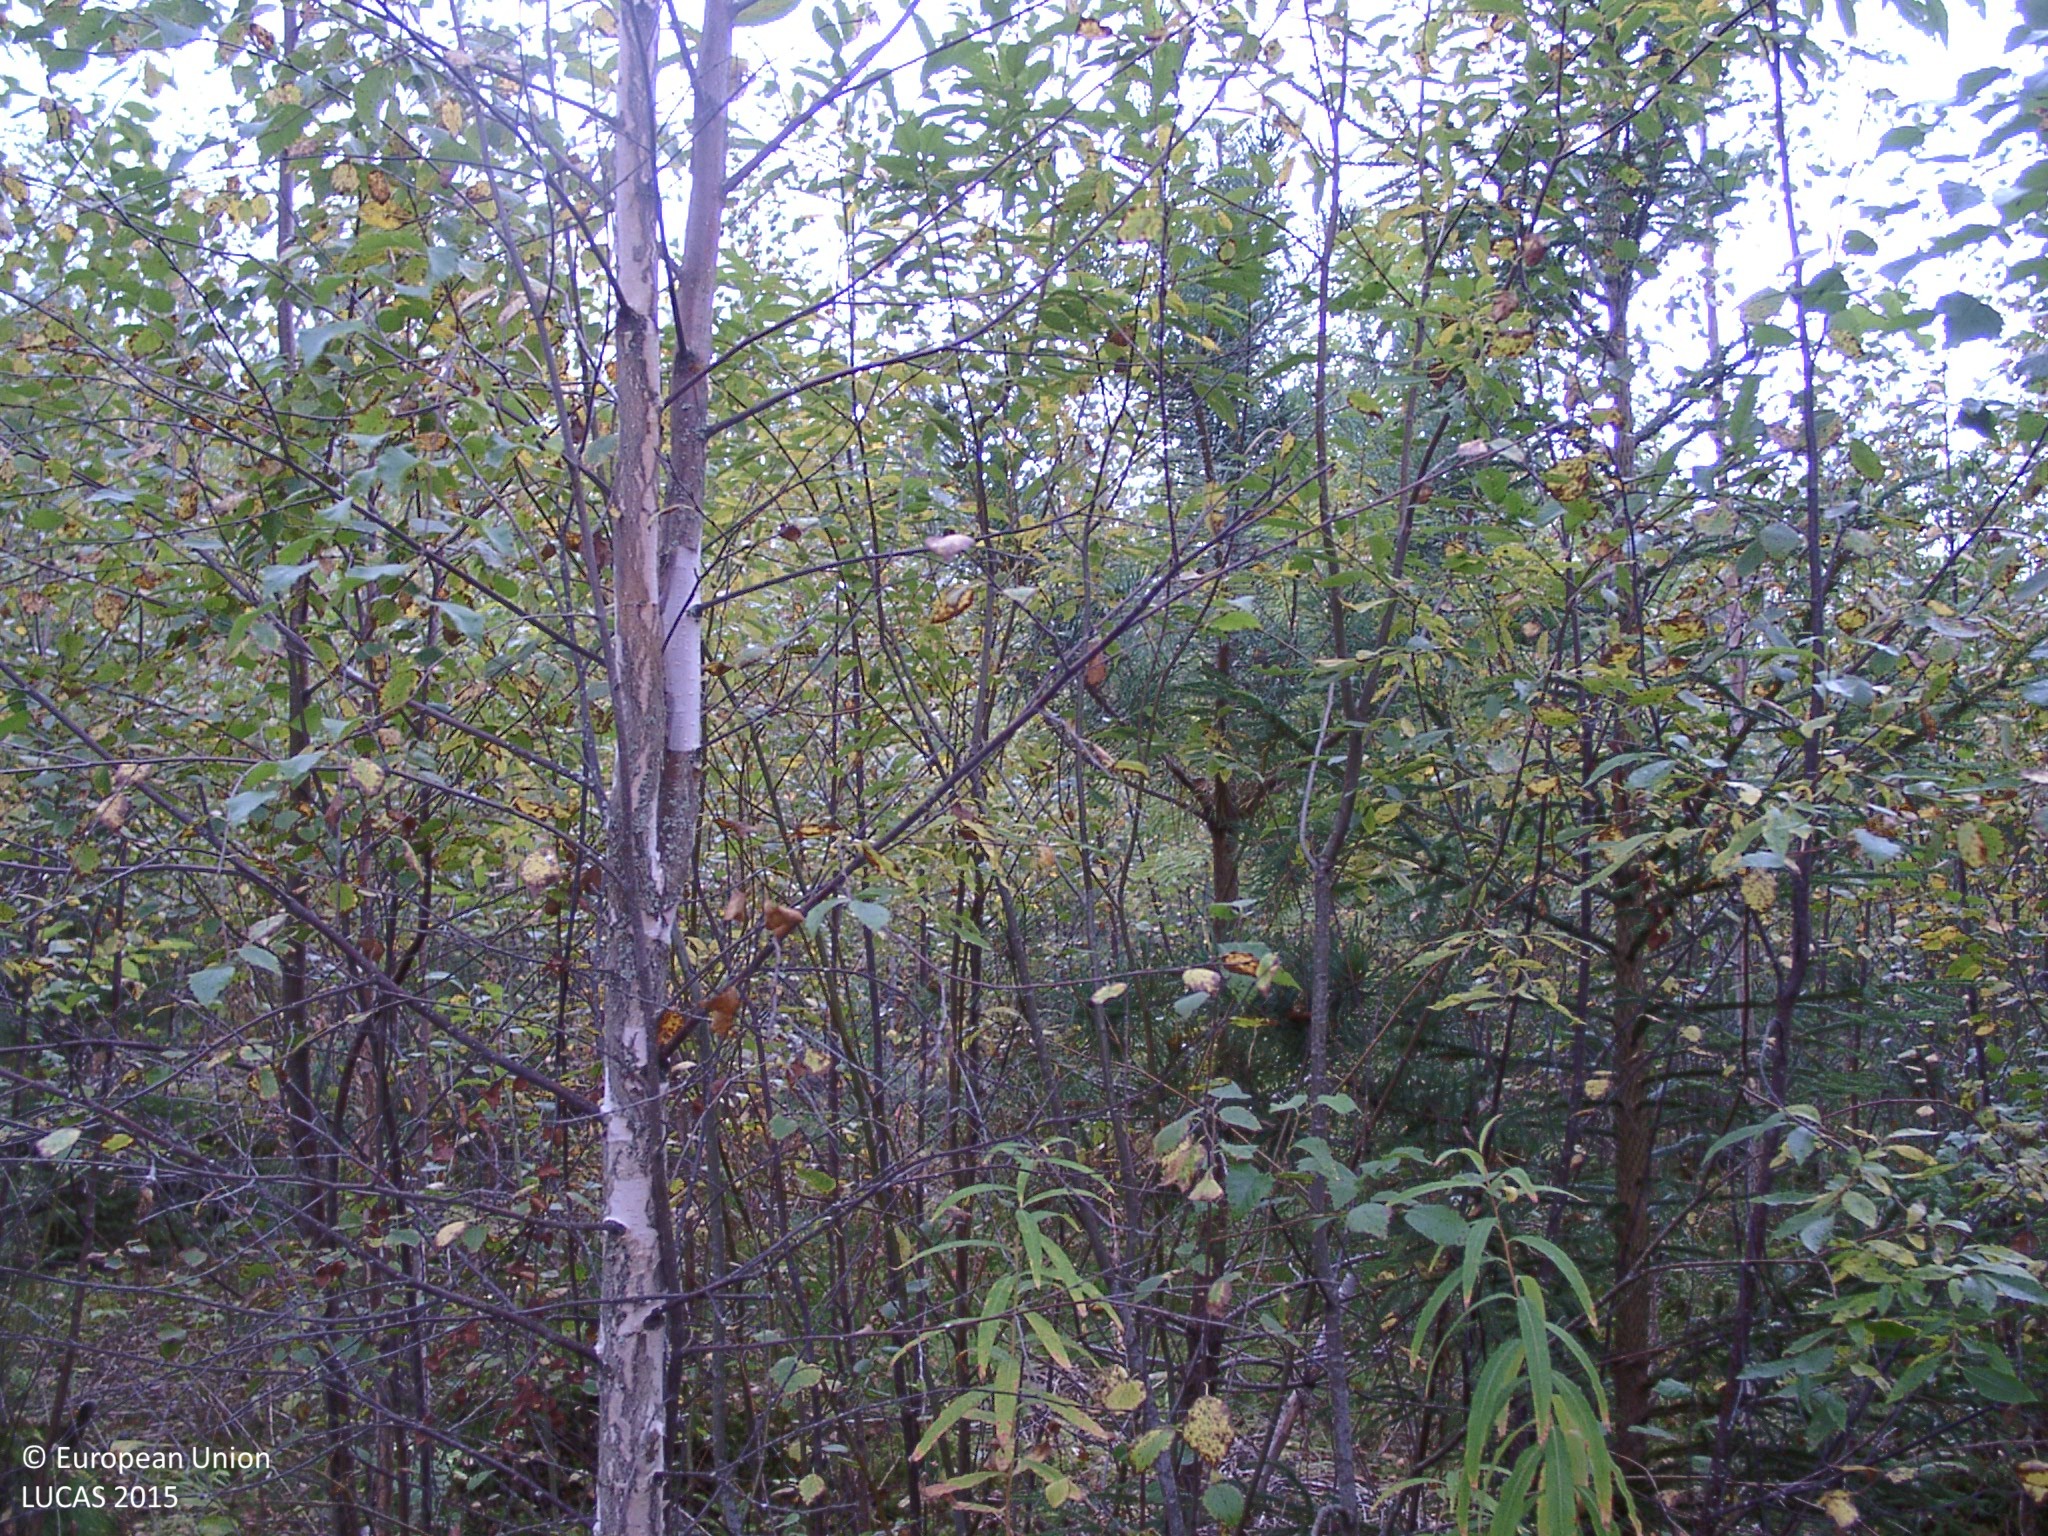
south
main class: Woodland
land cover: Broadleaved woodland
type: boreal forest
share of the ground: 50 - 75 %
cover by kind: broadleaved forest trees 60 %, lichens and mosses 20 %, coniferous forest trees 5 %, shrubs 5 %, herbaceous plants 5 %
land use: Forestry
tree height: < 5 m
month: September
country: FI
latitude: 62.8784
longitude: 25.2618
